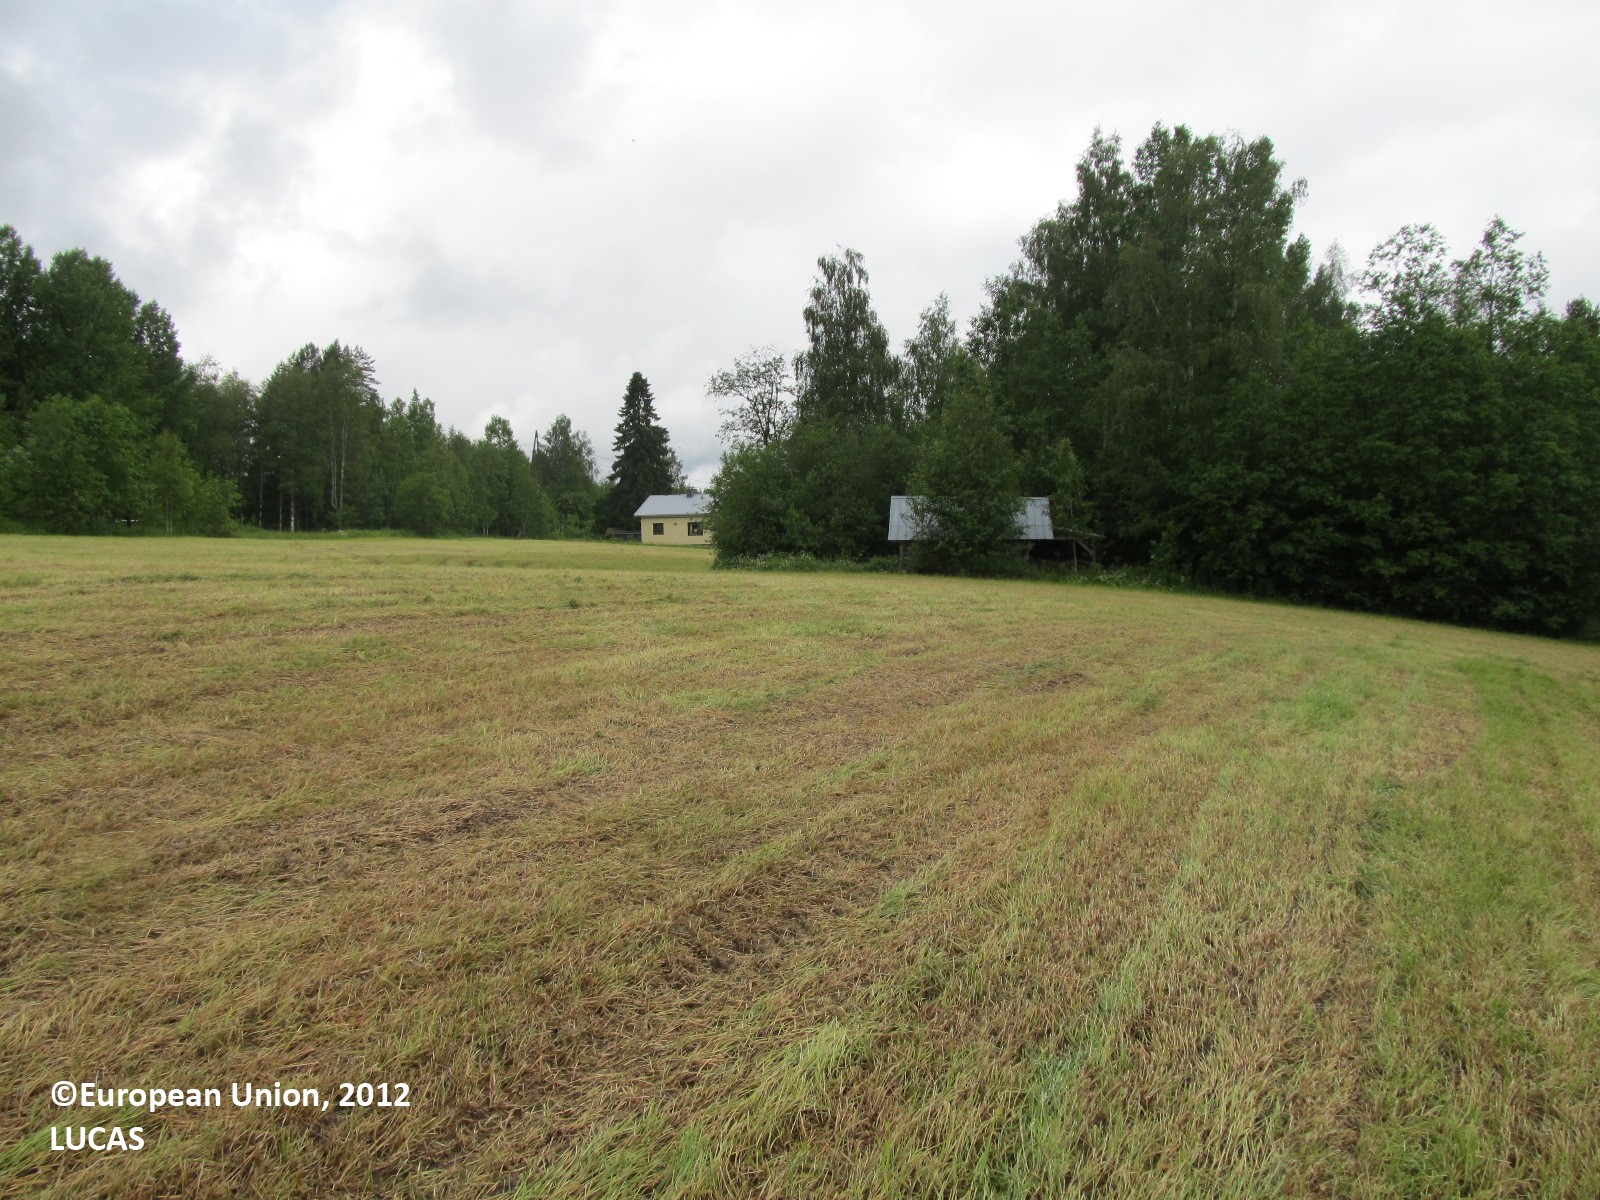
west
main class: Cropland
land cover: Temporary grasslands
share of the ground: > 75 %
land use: Agriculture (excluding fallow land and kitchen gardens)
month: June
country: FI
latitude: 63.1040
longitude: 28.9757
